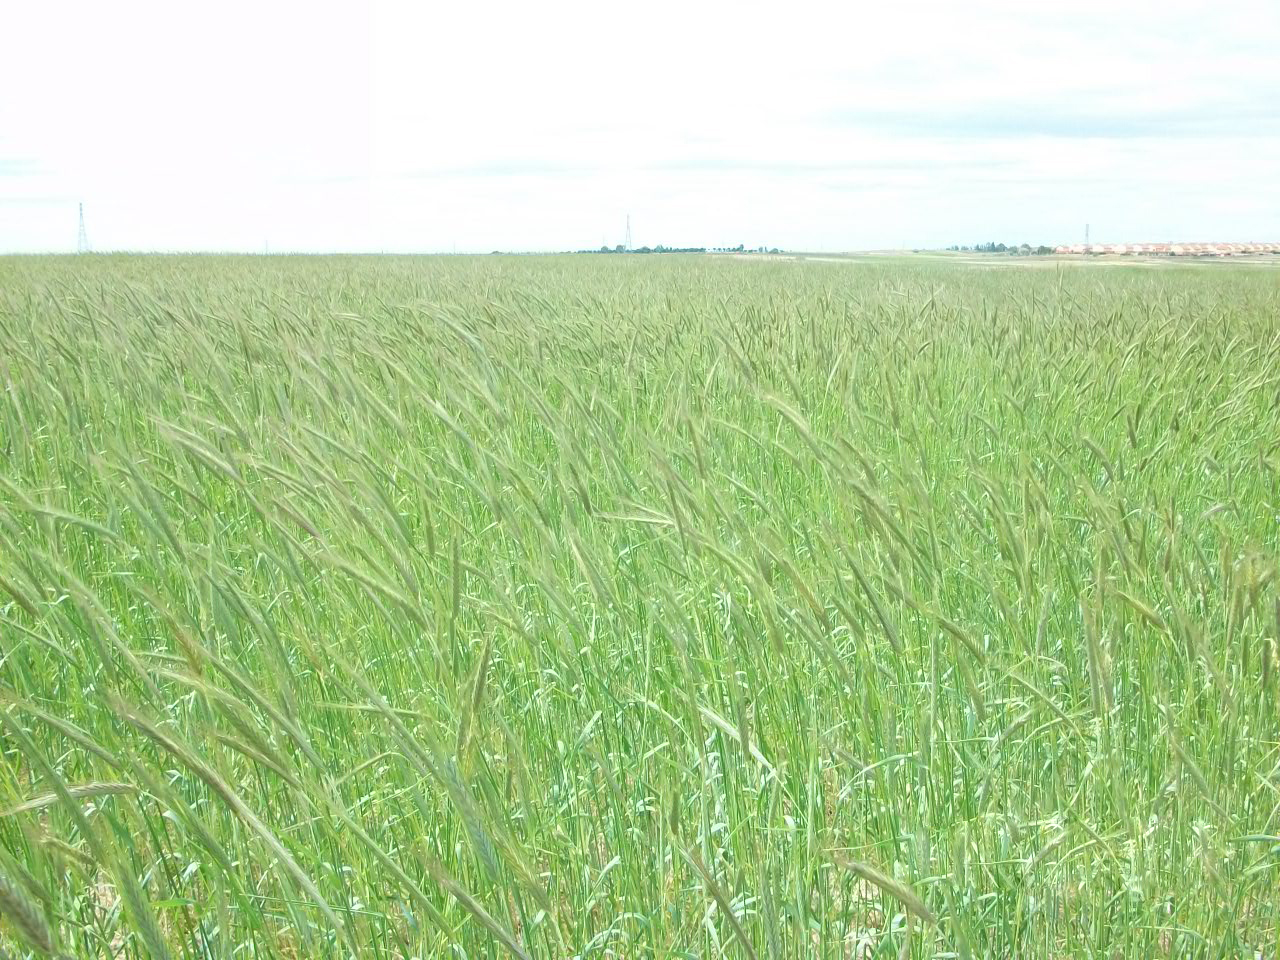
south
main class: Cropland
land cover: Rye
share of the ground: > 75 %
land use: Agriculture (excluding fallow land and kitchen gardens)
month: May
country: ES
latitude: 40.2008
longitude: -3.8163
